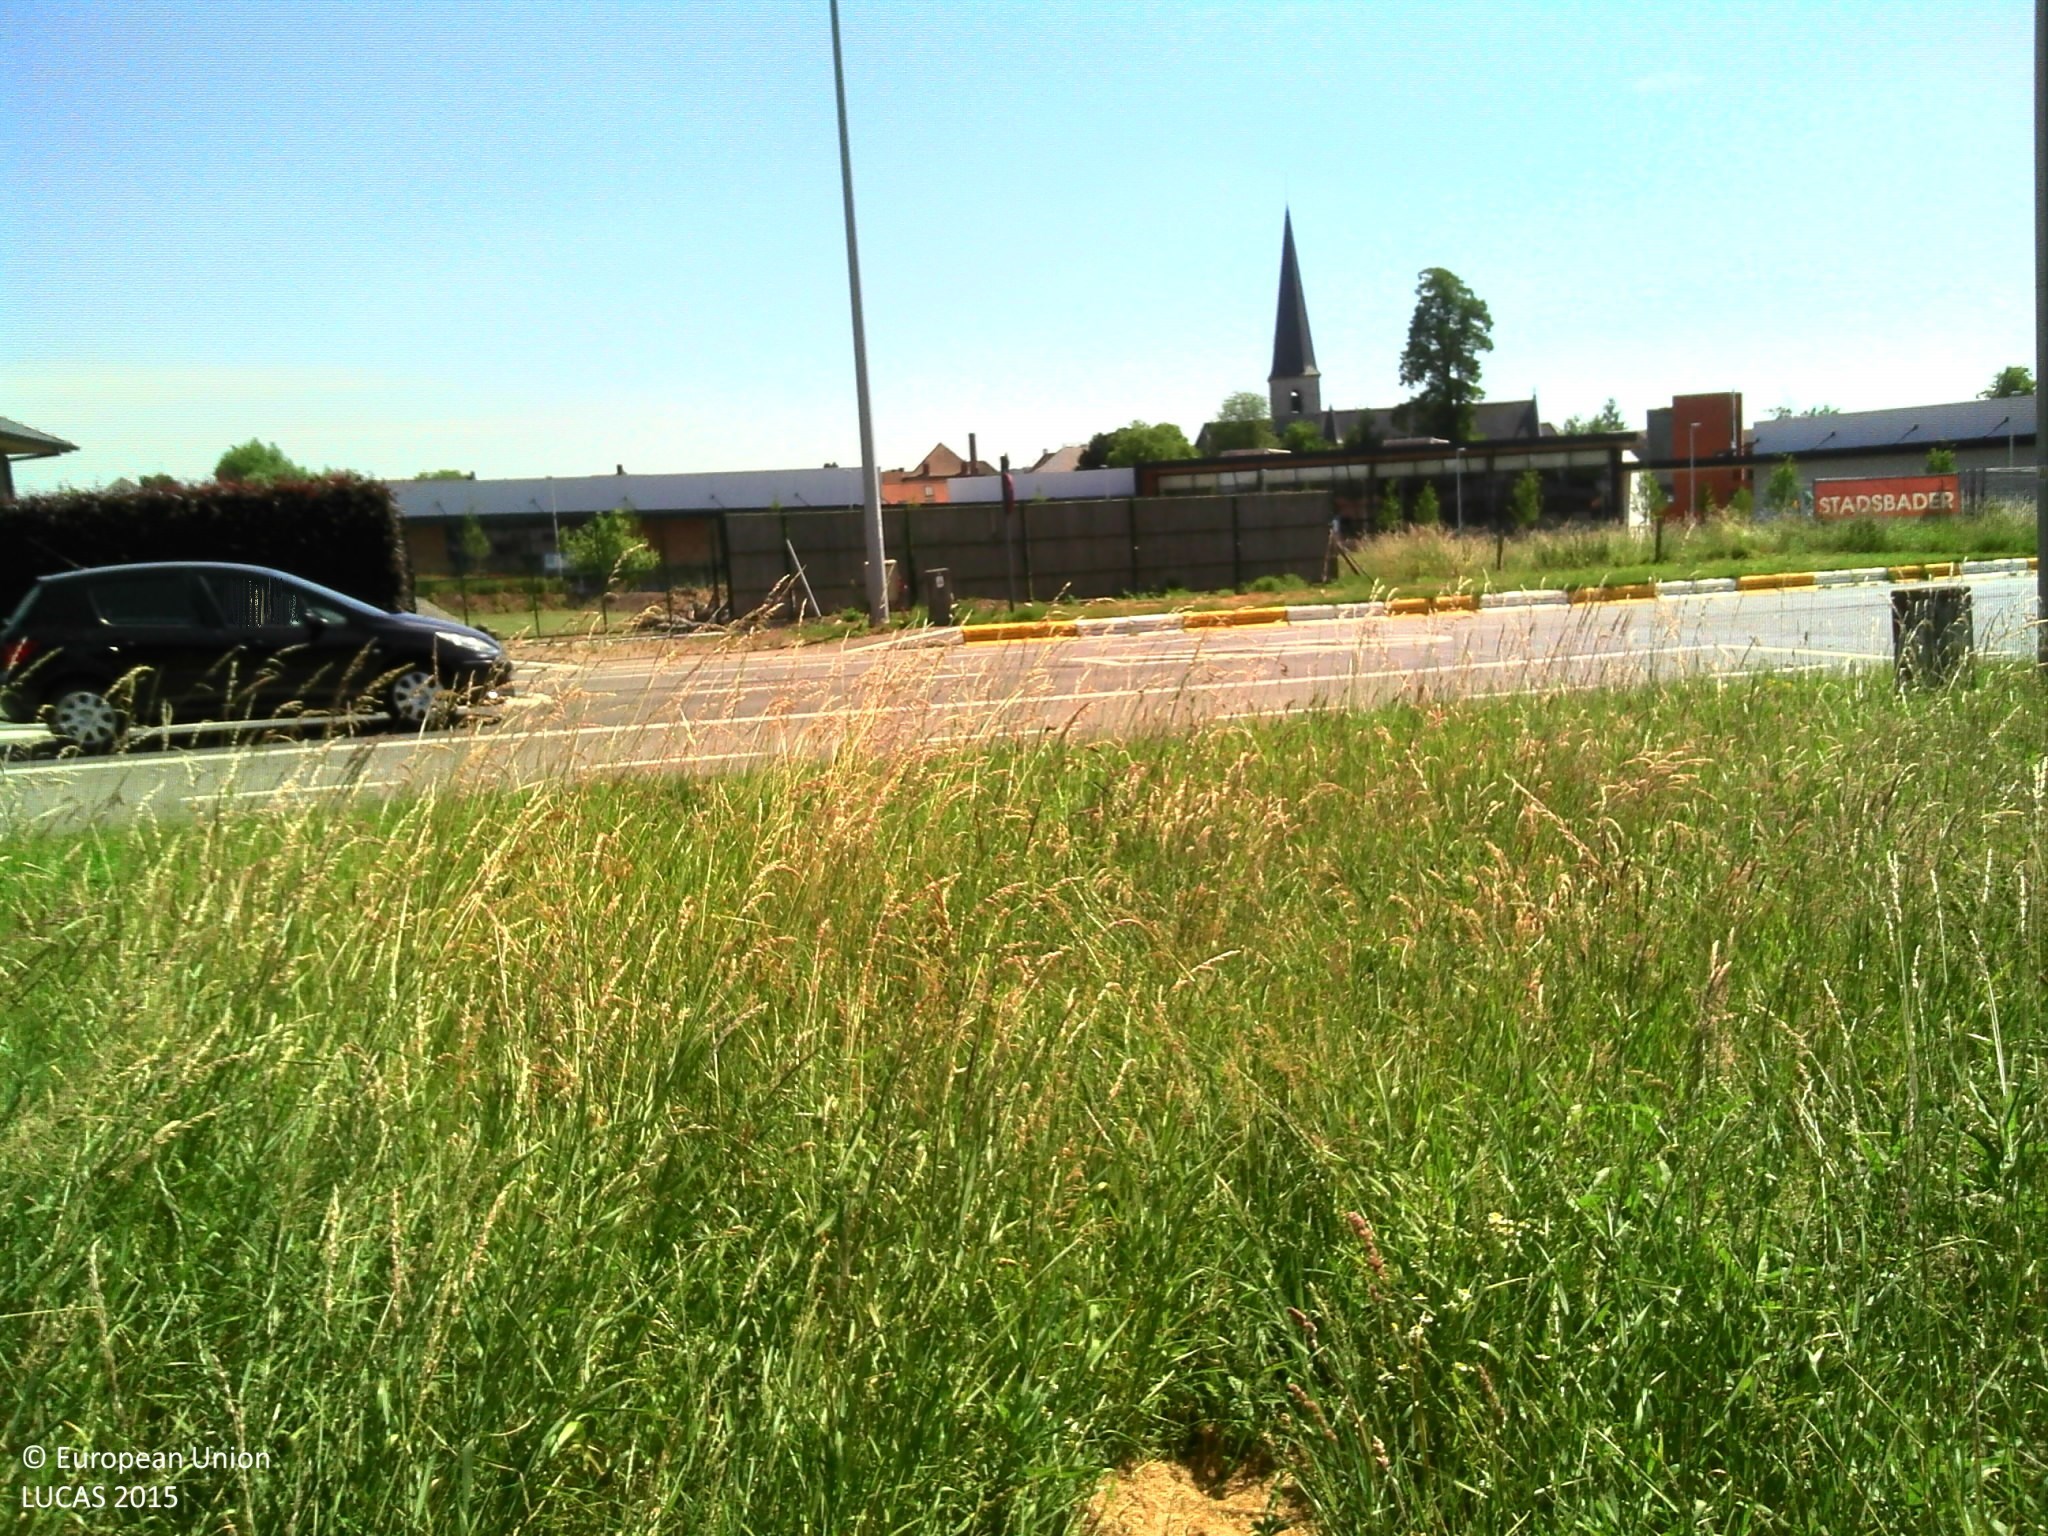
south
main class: Grassland
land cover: Grassland without tree/shrub cover
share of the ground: > 75 %
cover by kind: herbaceous plants 100 %
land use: Road transport
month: June
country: BE
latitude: 50.7930
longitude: 3.5090
